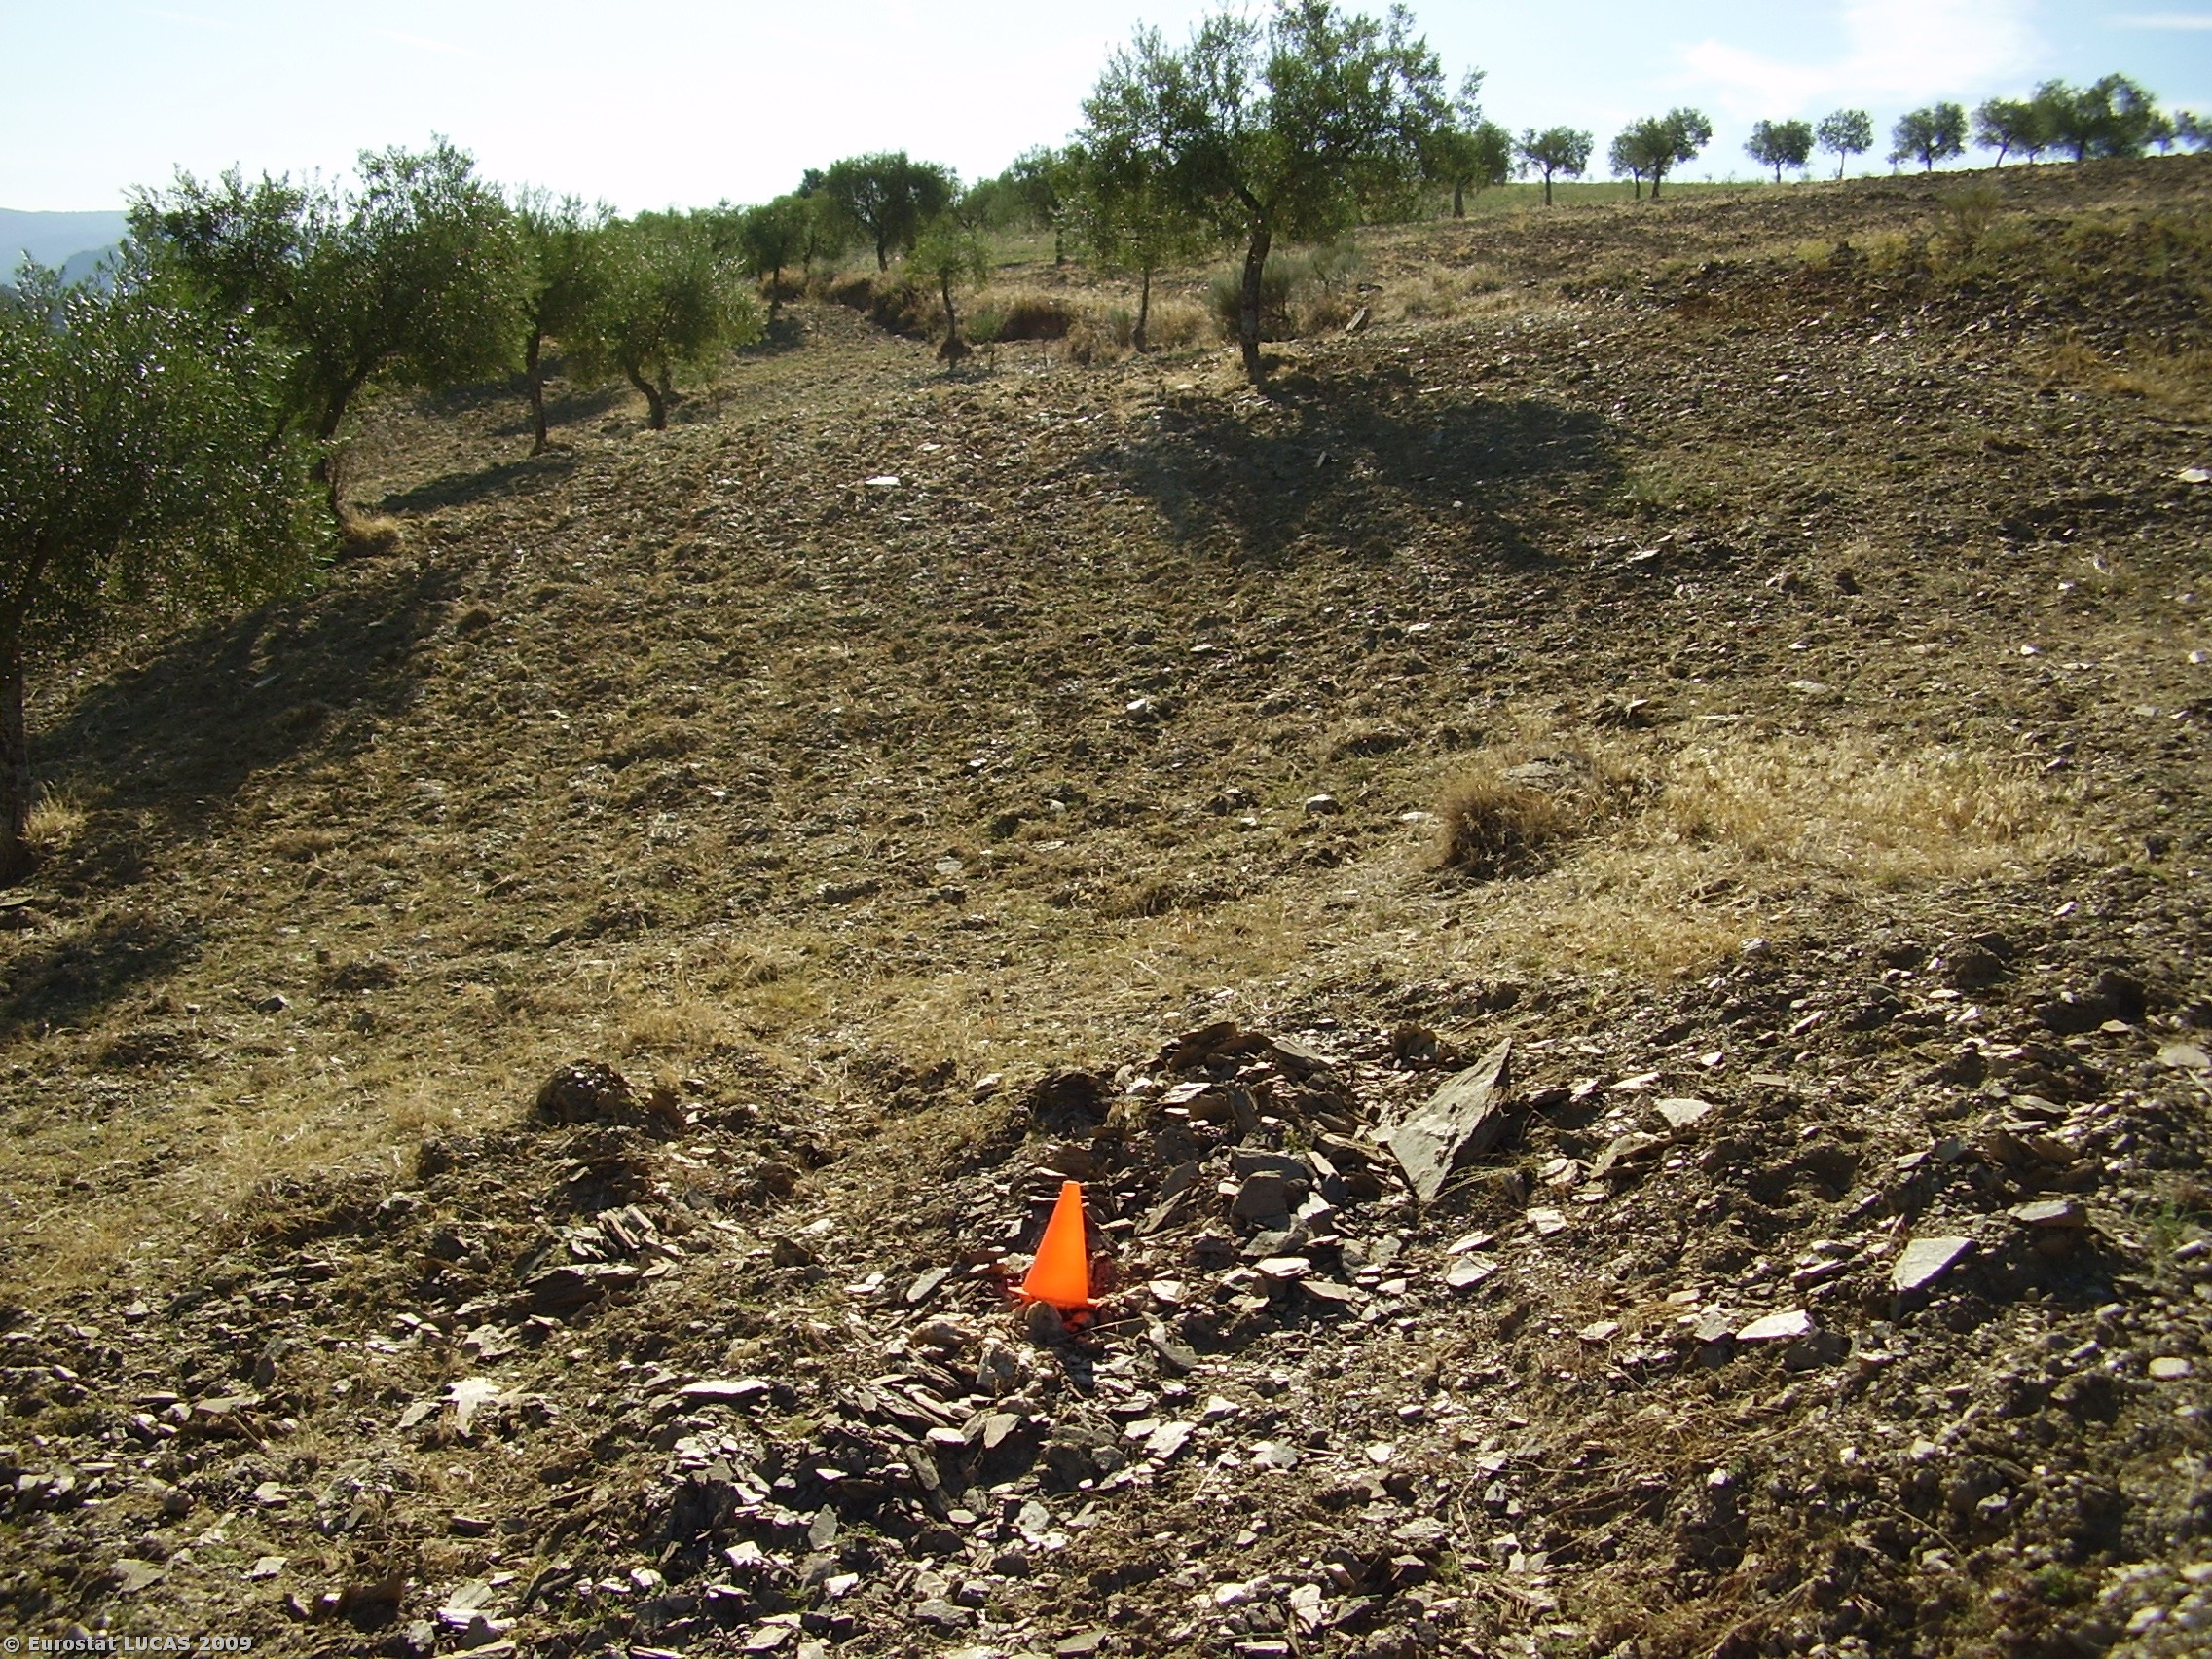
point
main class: Cropland
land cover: Olive groves
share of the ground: 10 - 25 %
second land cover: Spontaneously vegetated surfaces
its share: < 10 %
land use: Agriculture (excluding fallow land and kitchen gardens)
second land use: Fallow land
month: August
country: PT
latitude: 41.4270
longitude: -6.7768
